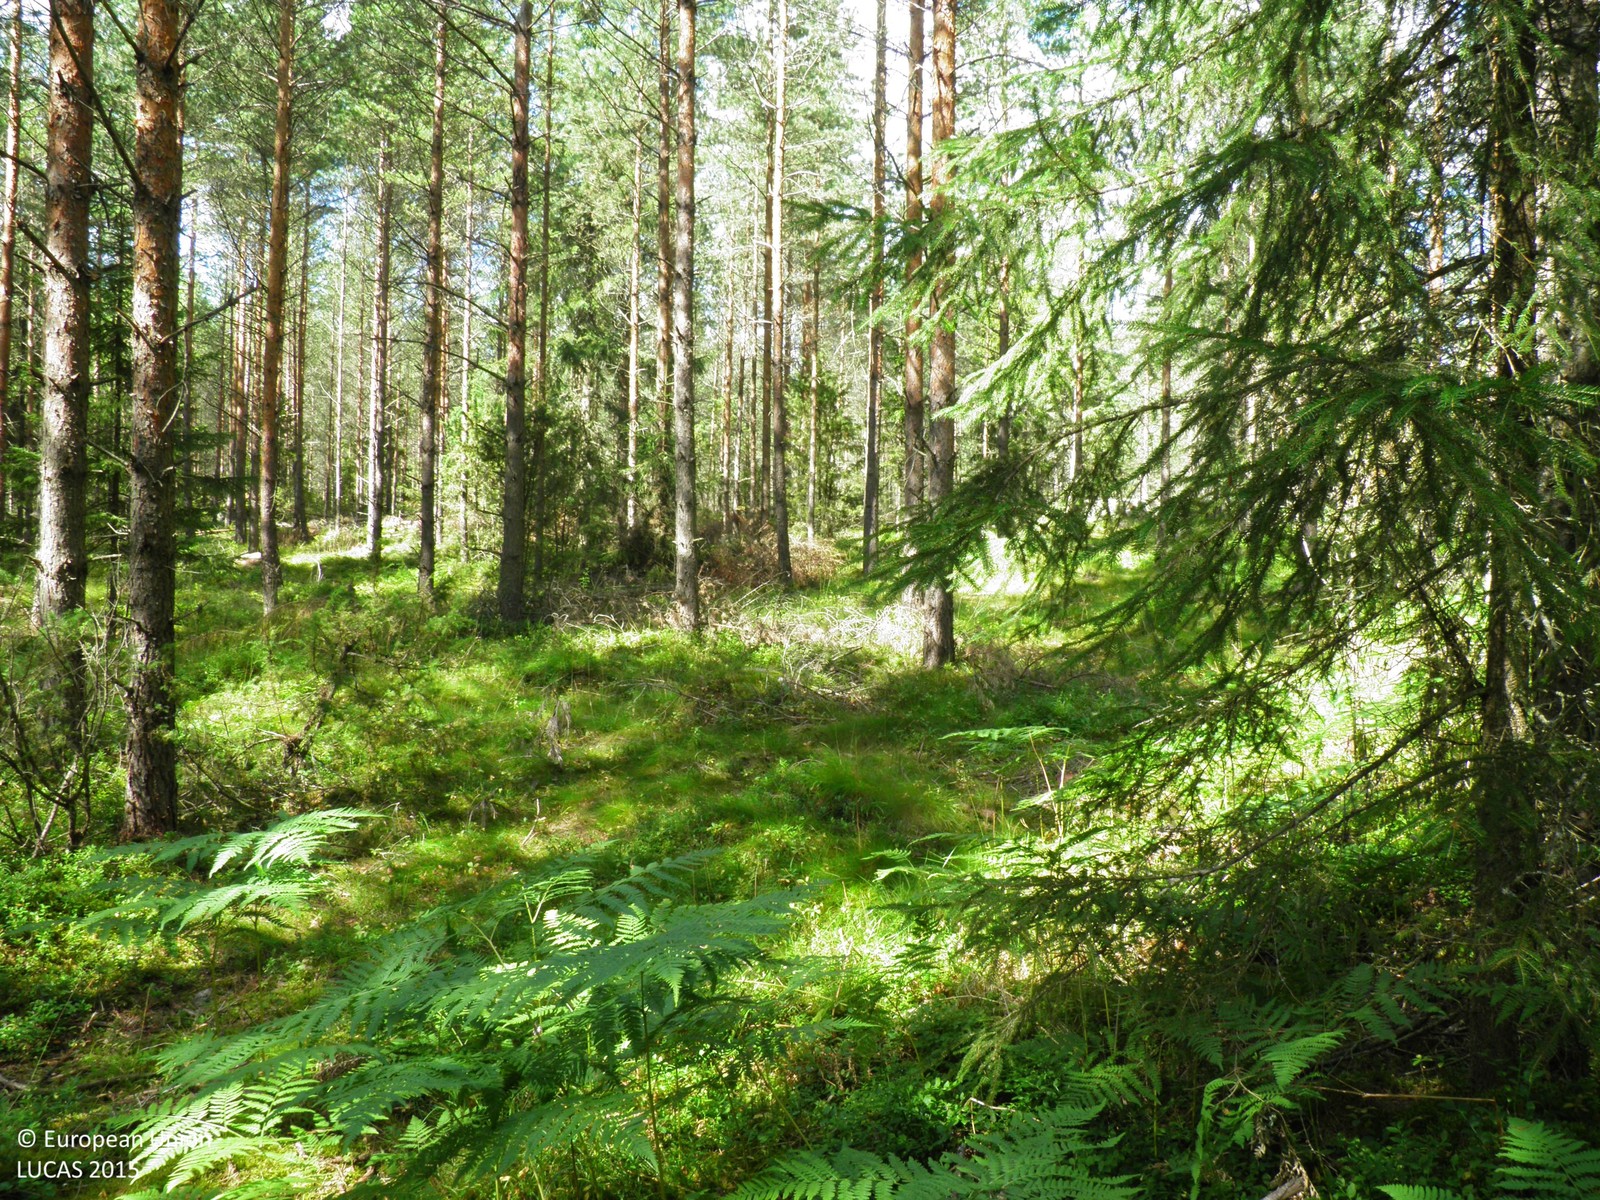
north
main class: Woodland
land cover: Pine dominated coniferous woodland
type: hemiboreal forest and nemoral coniferous forest and mixed broadleaved-coniferous forest
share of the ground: 50 - 75 %
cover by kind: coniferous forest trees 60 %, shrubs 15 %, herbaceous plants 10 %, lichens and mosses 10 %, broadleaved forest trees 5 %
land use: Forestry
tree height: > 5 m
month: August
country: FI
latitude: 60.9800
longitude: 22.8414
